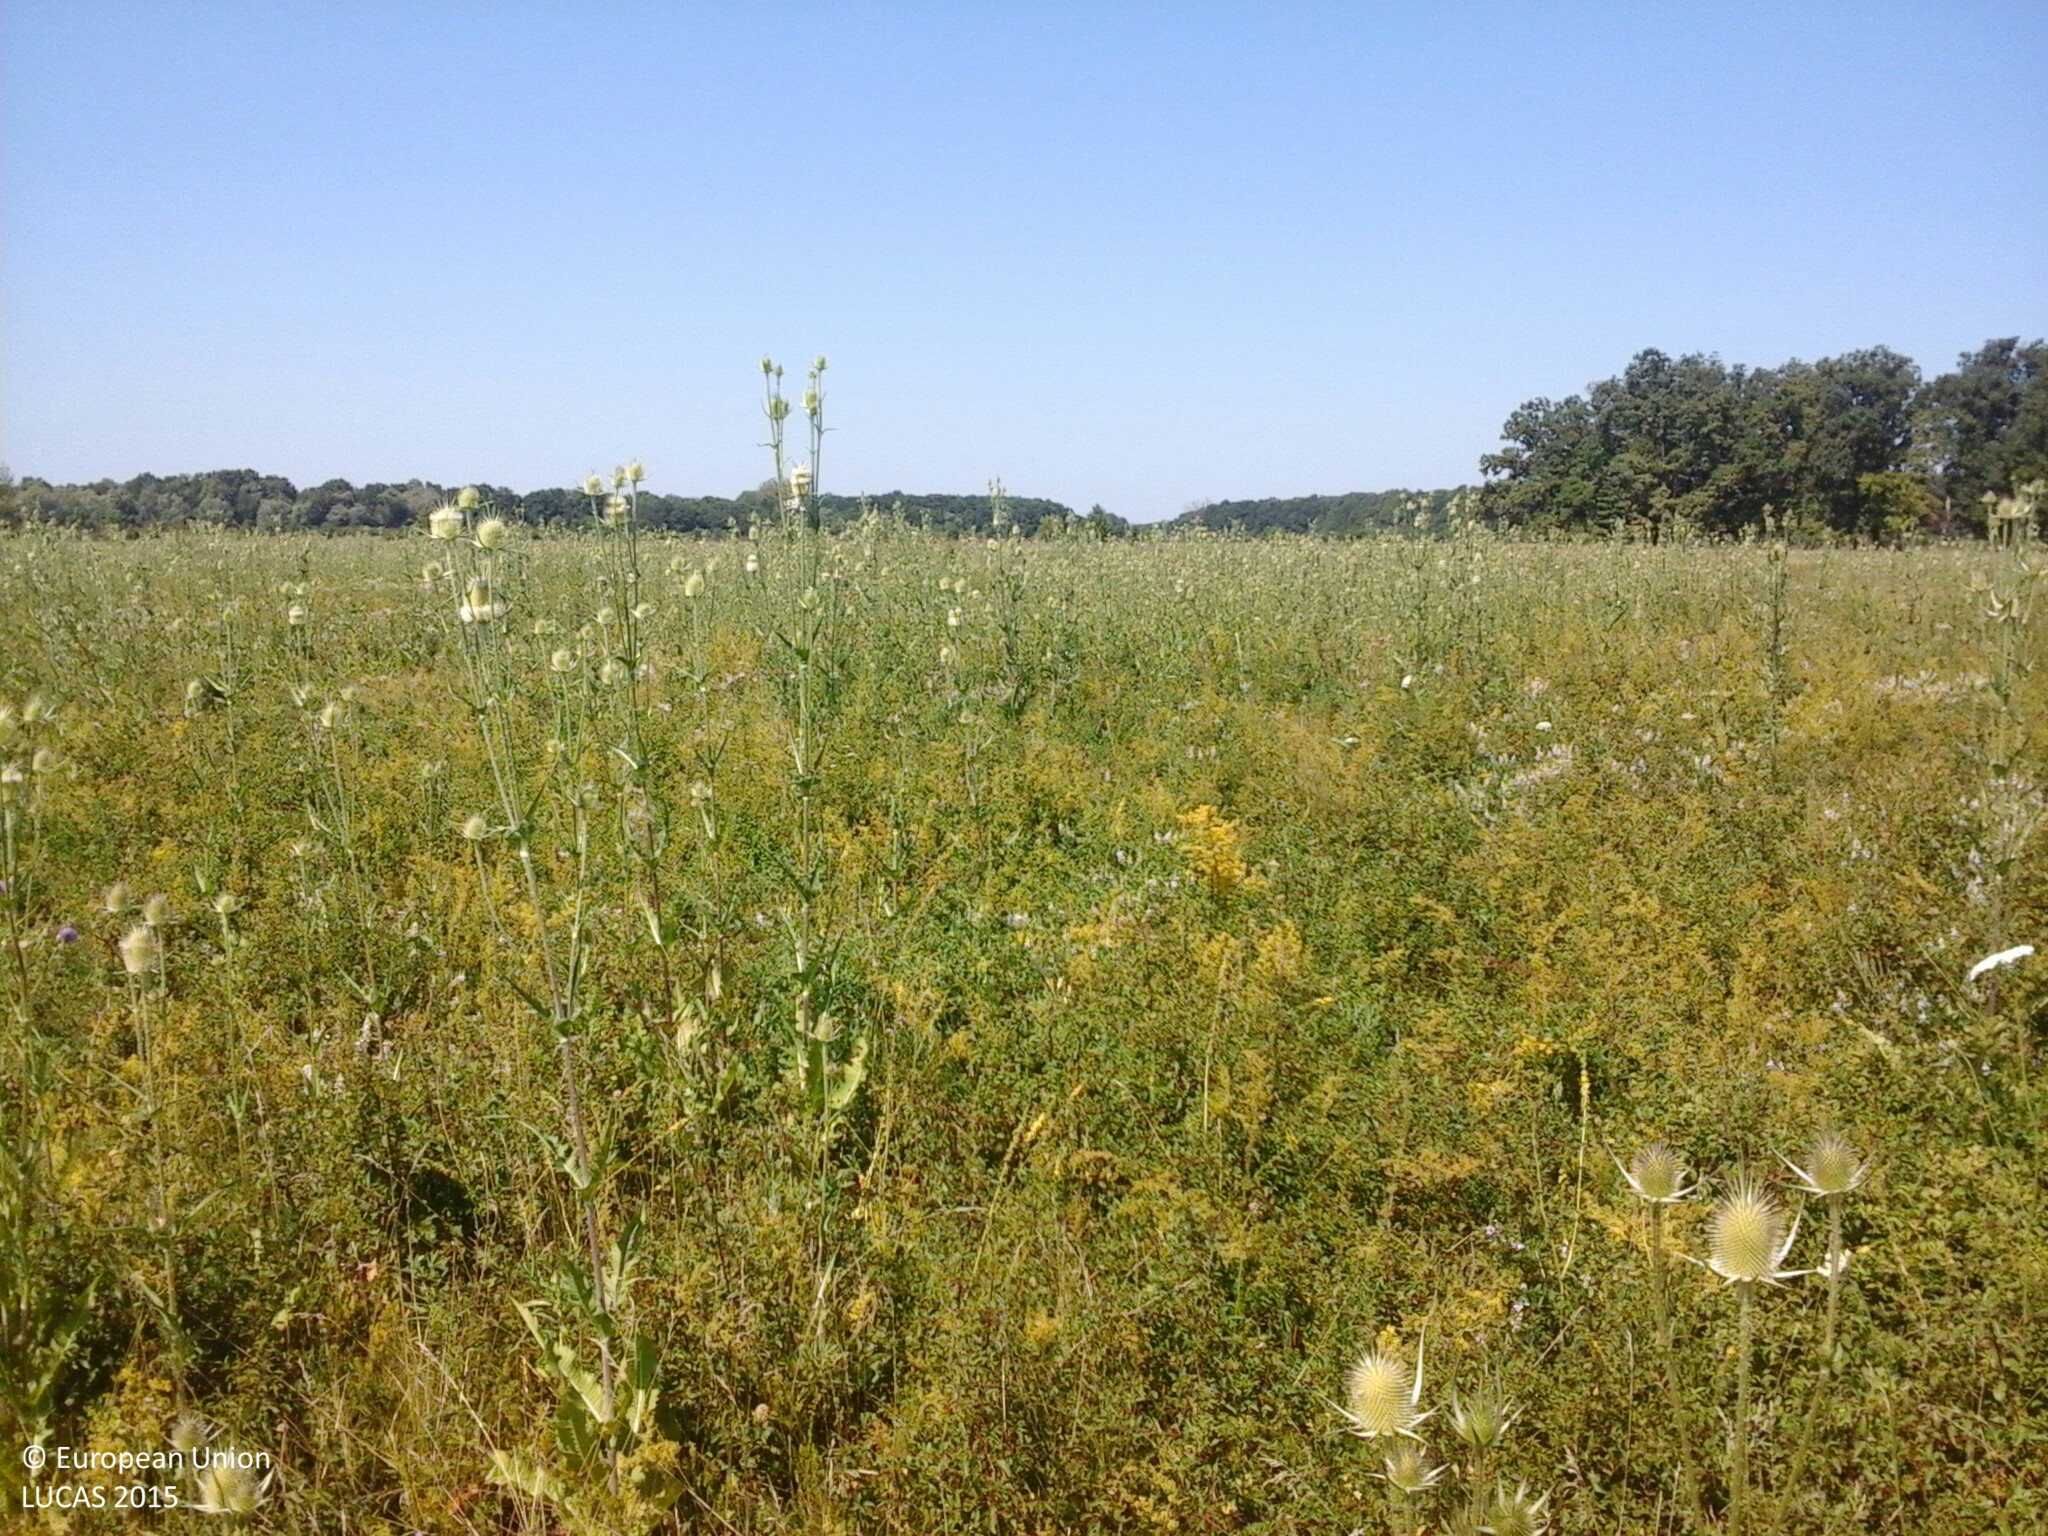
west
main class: Grassland
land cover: Spontaneously vegetated surfaces
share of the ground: > 75 %
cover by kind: herbaceous plants 100 %
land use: Semi-natural and natural areas not in use
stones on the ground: < 10 %
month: July
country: HU
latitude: 48.1205
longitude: 22.4043
